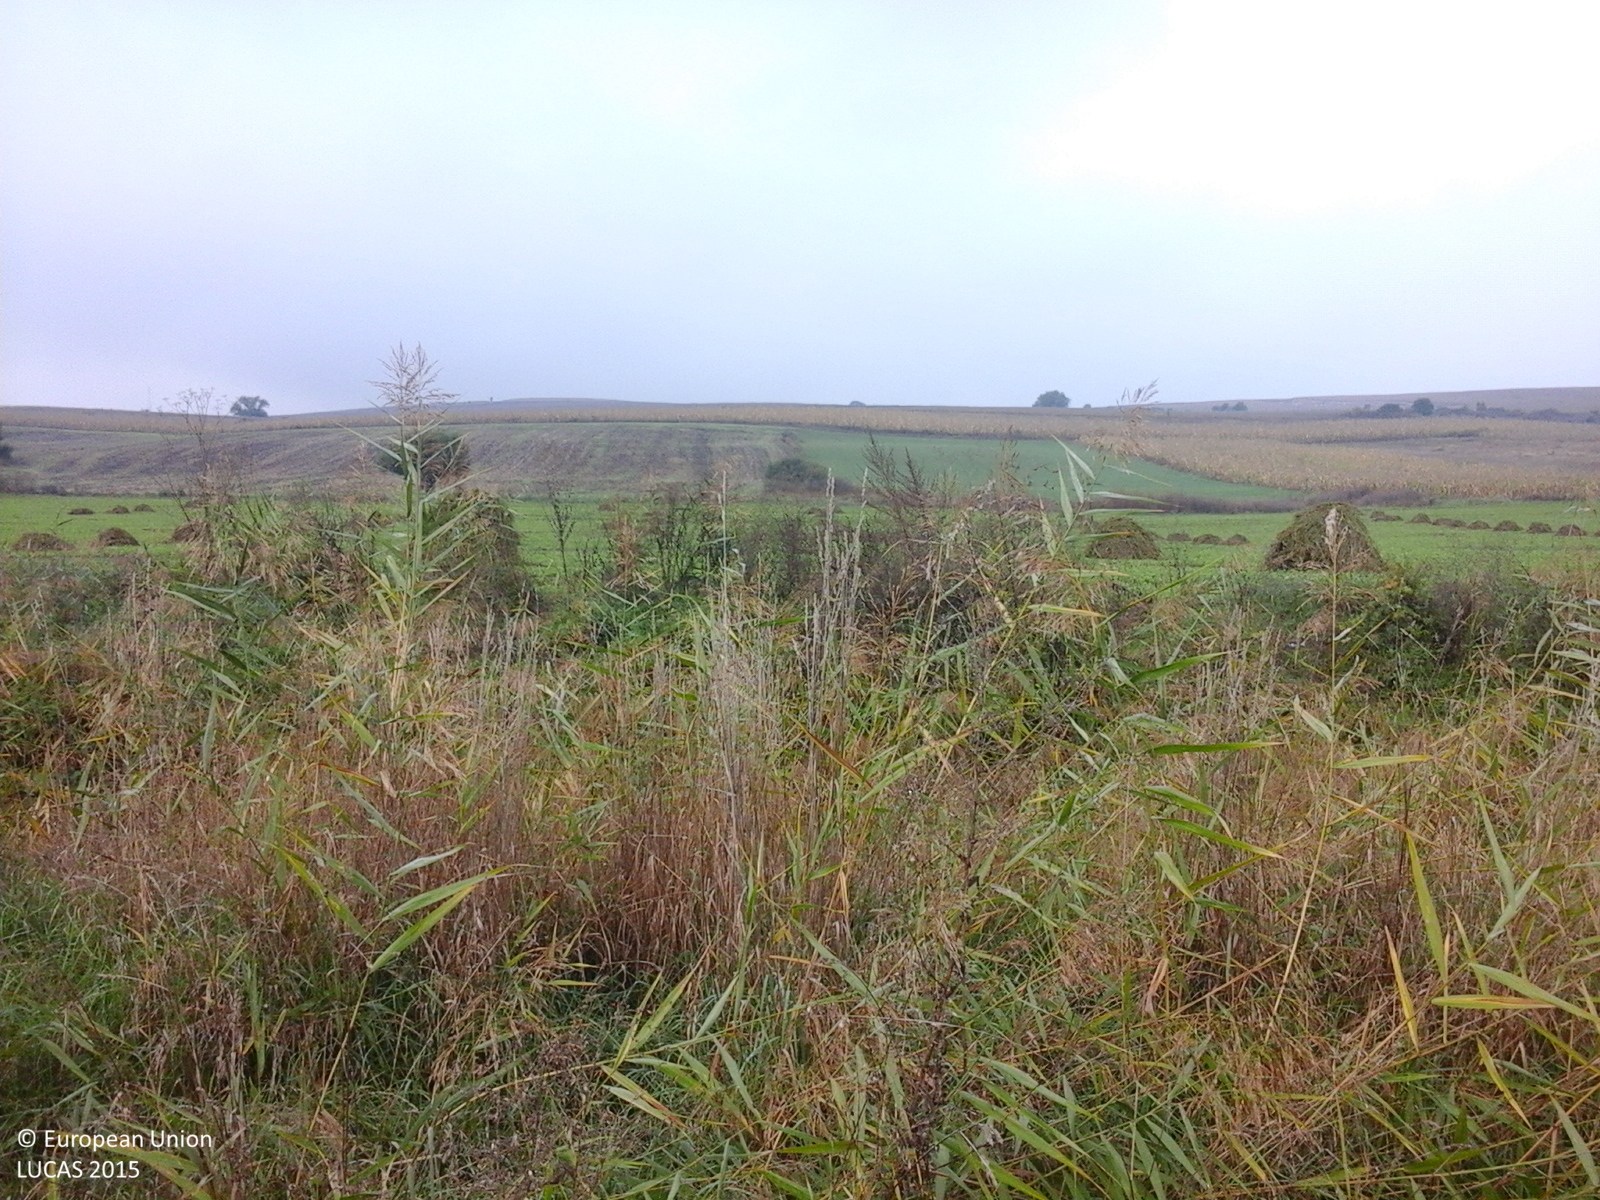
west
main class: Grassland
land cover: Spontaneously vegetated surfaces
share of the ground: > 75 %
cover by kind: herbaceous plants 100 %
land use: Agriculture (excluding fallow land and kitchen gardens)
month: October
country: RO
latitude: 46.0186
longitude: 23.9320
